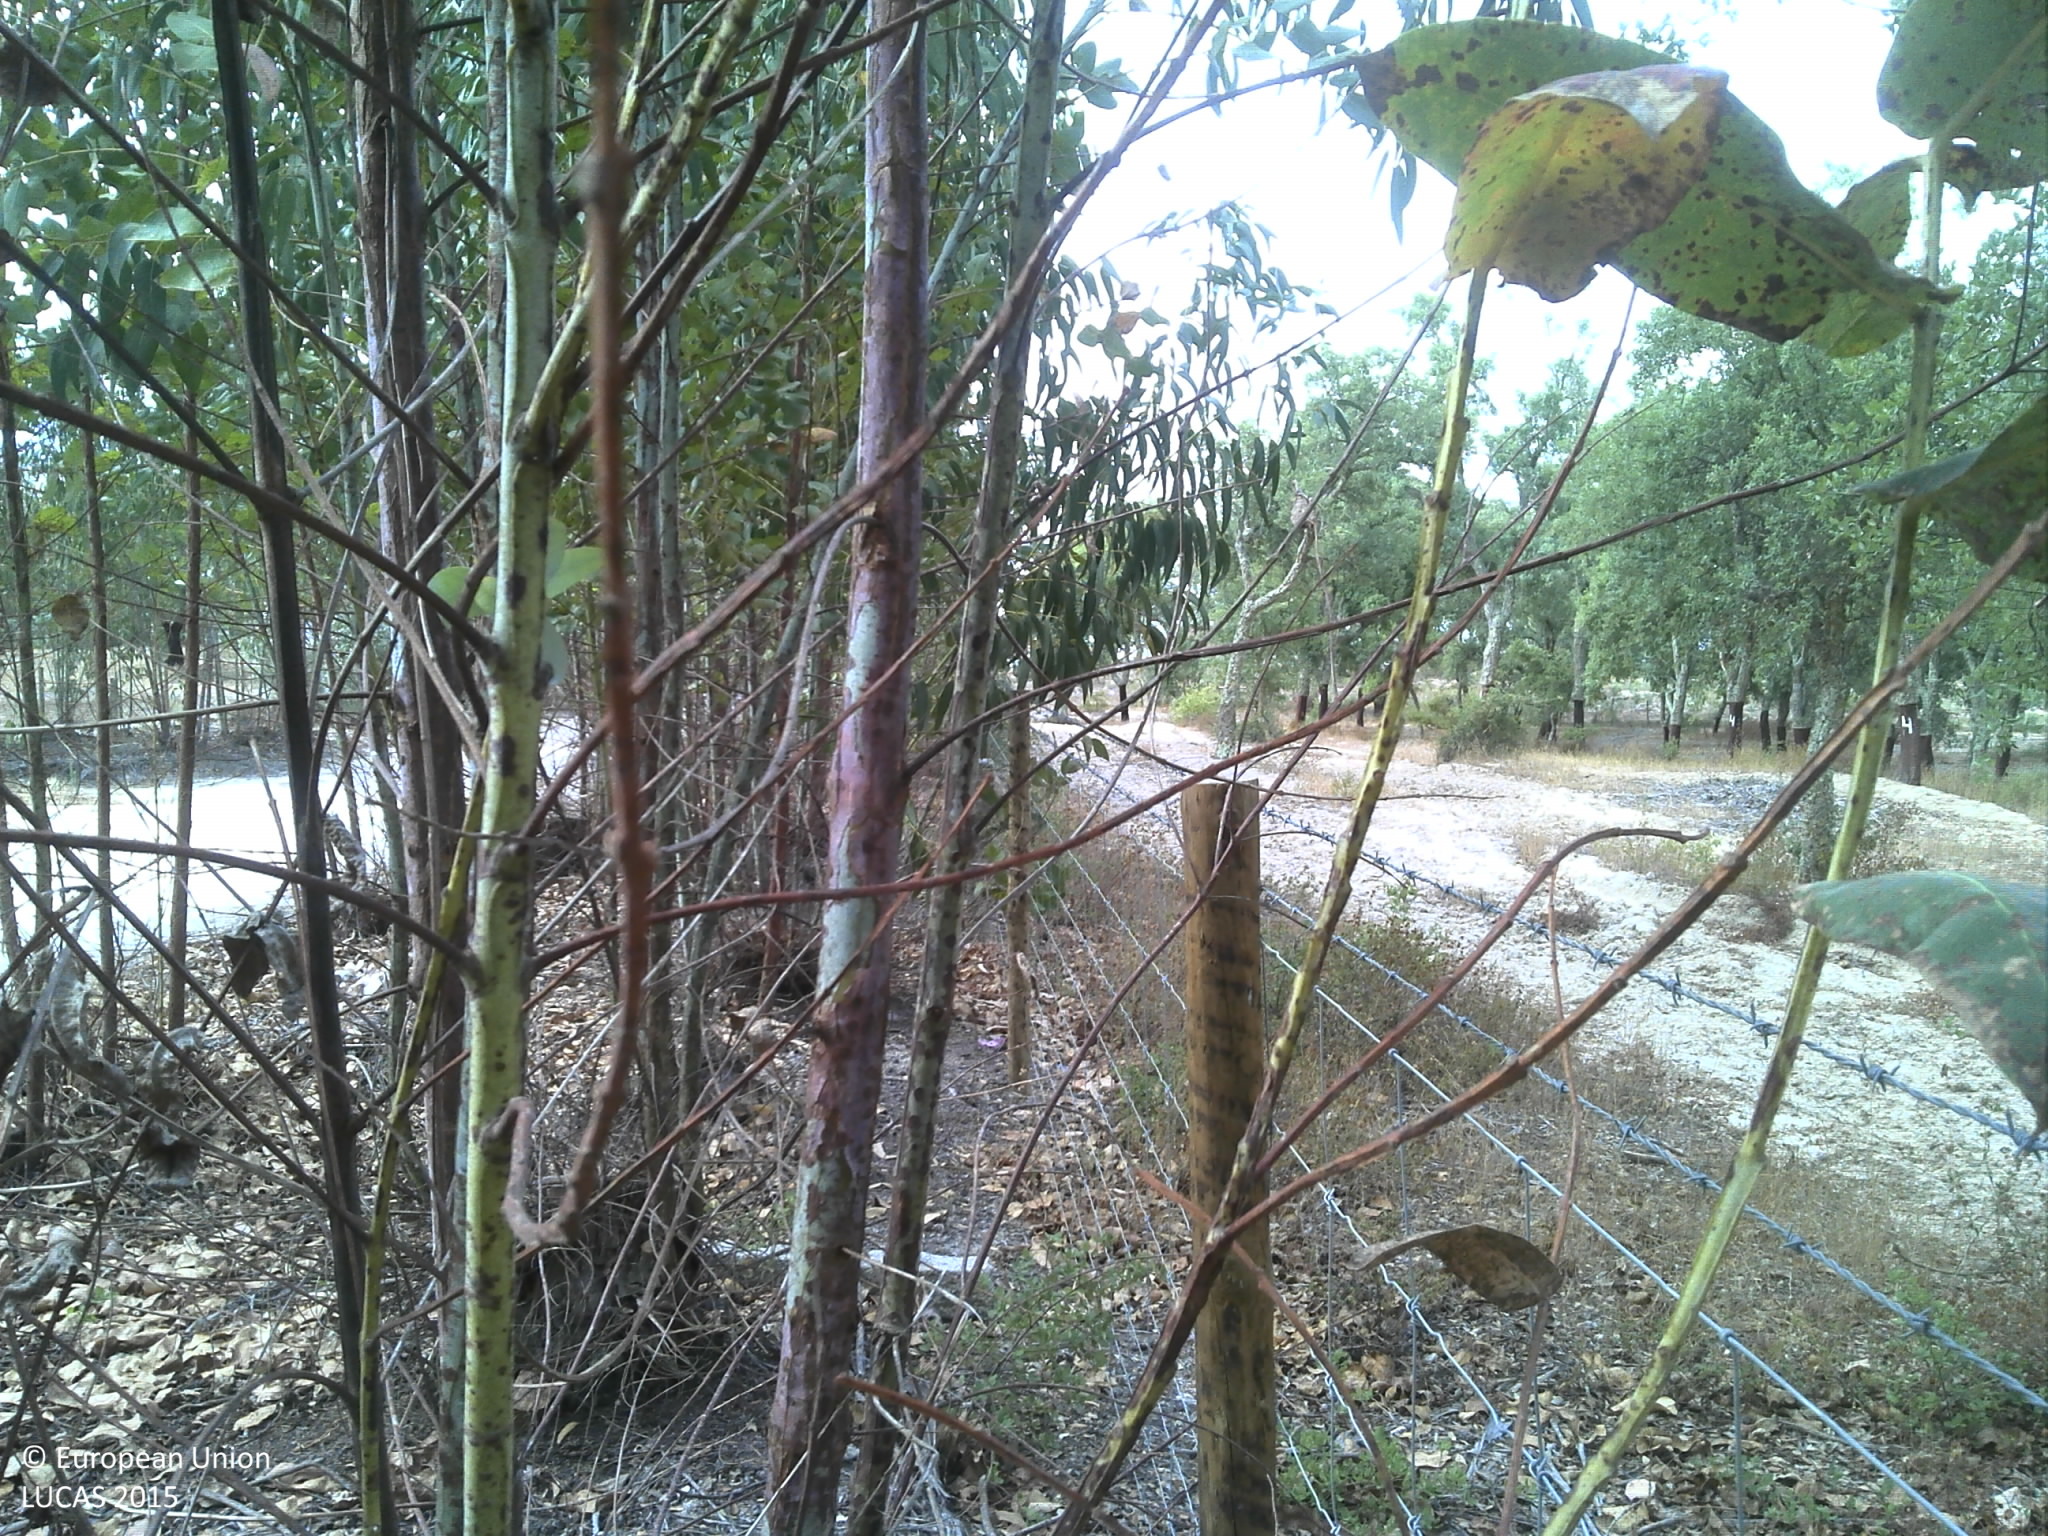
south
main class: Woodland
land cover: Broadleaved woodland
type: broadleaved evergreen forest
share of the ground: 50 - 75 %
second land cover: Grassland without tree/shrub cover
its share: 25 - 50 %
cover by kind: broadleaved forest trees 60 %, herbaceous plants 30 %, unconsolidated bare surface 10 %
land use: Forestry
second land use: Agriculture (excluding fallow land and kitchen gardens)
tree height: > 5 m
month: July
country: PT
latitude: 38.9200
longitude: -8.6698
